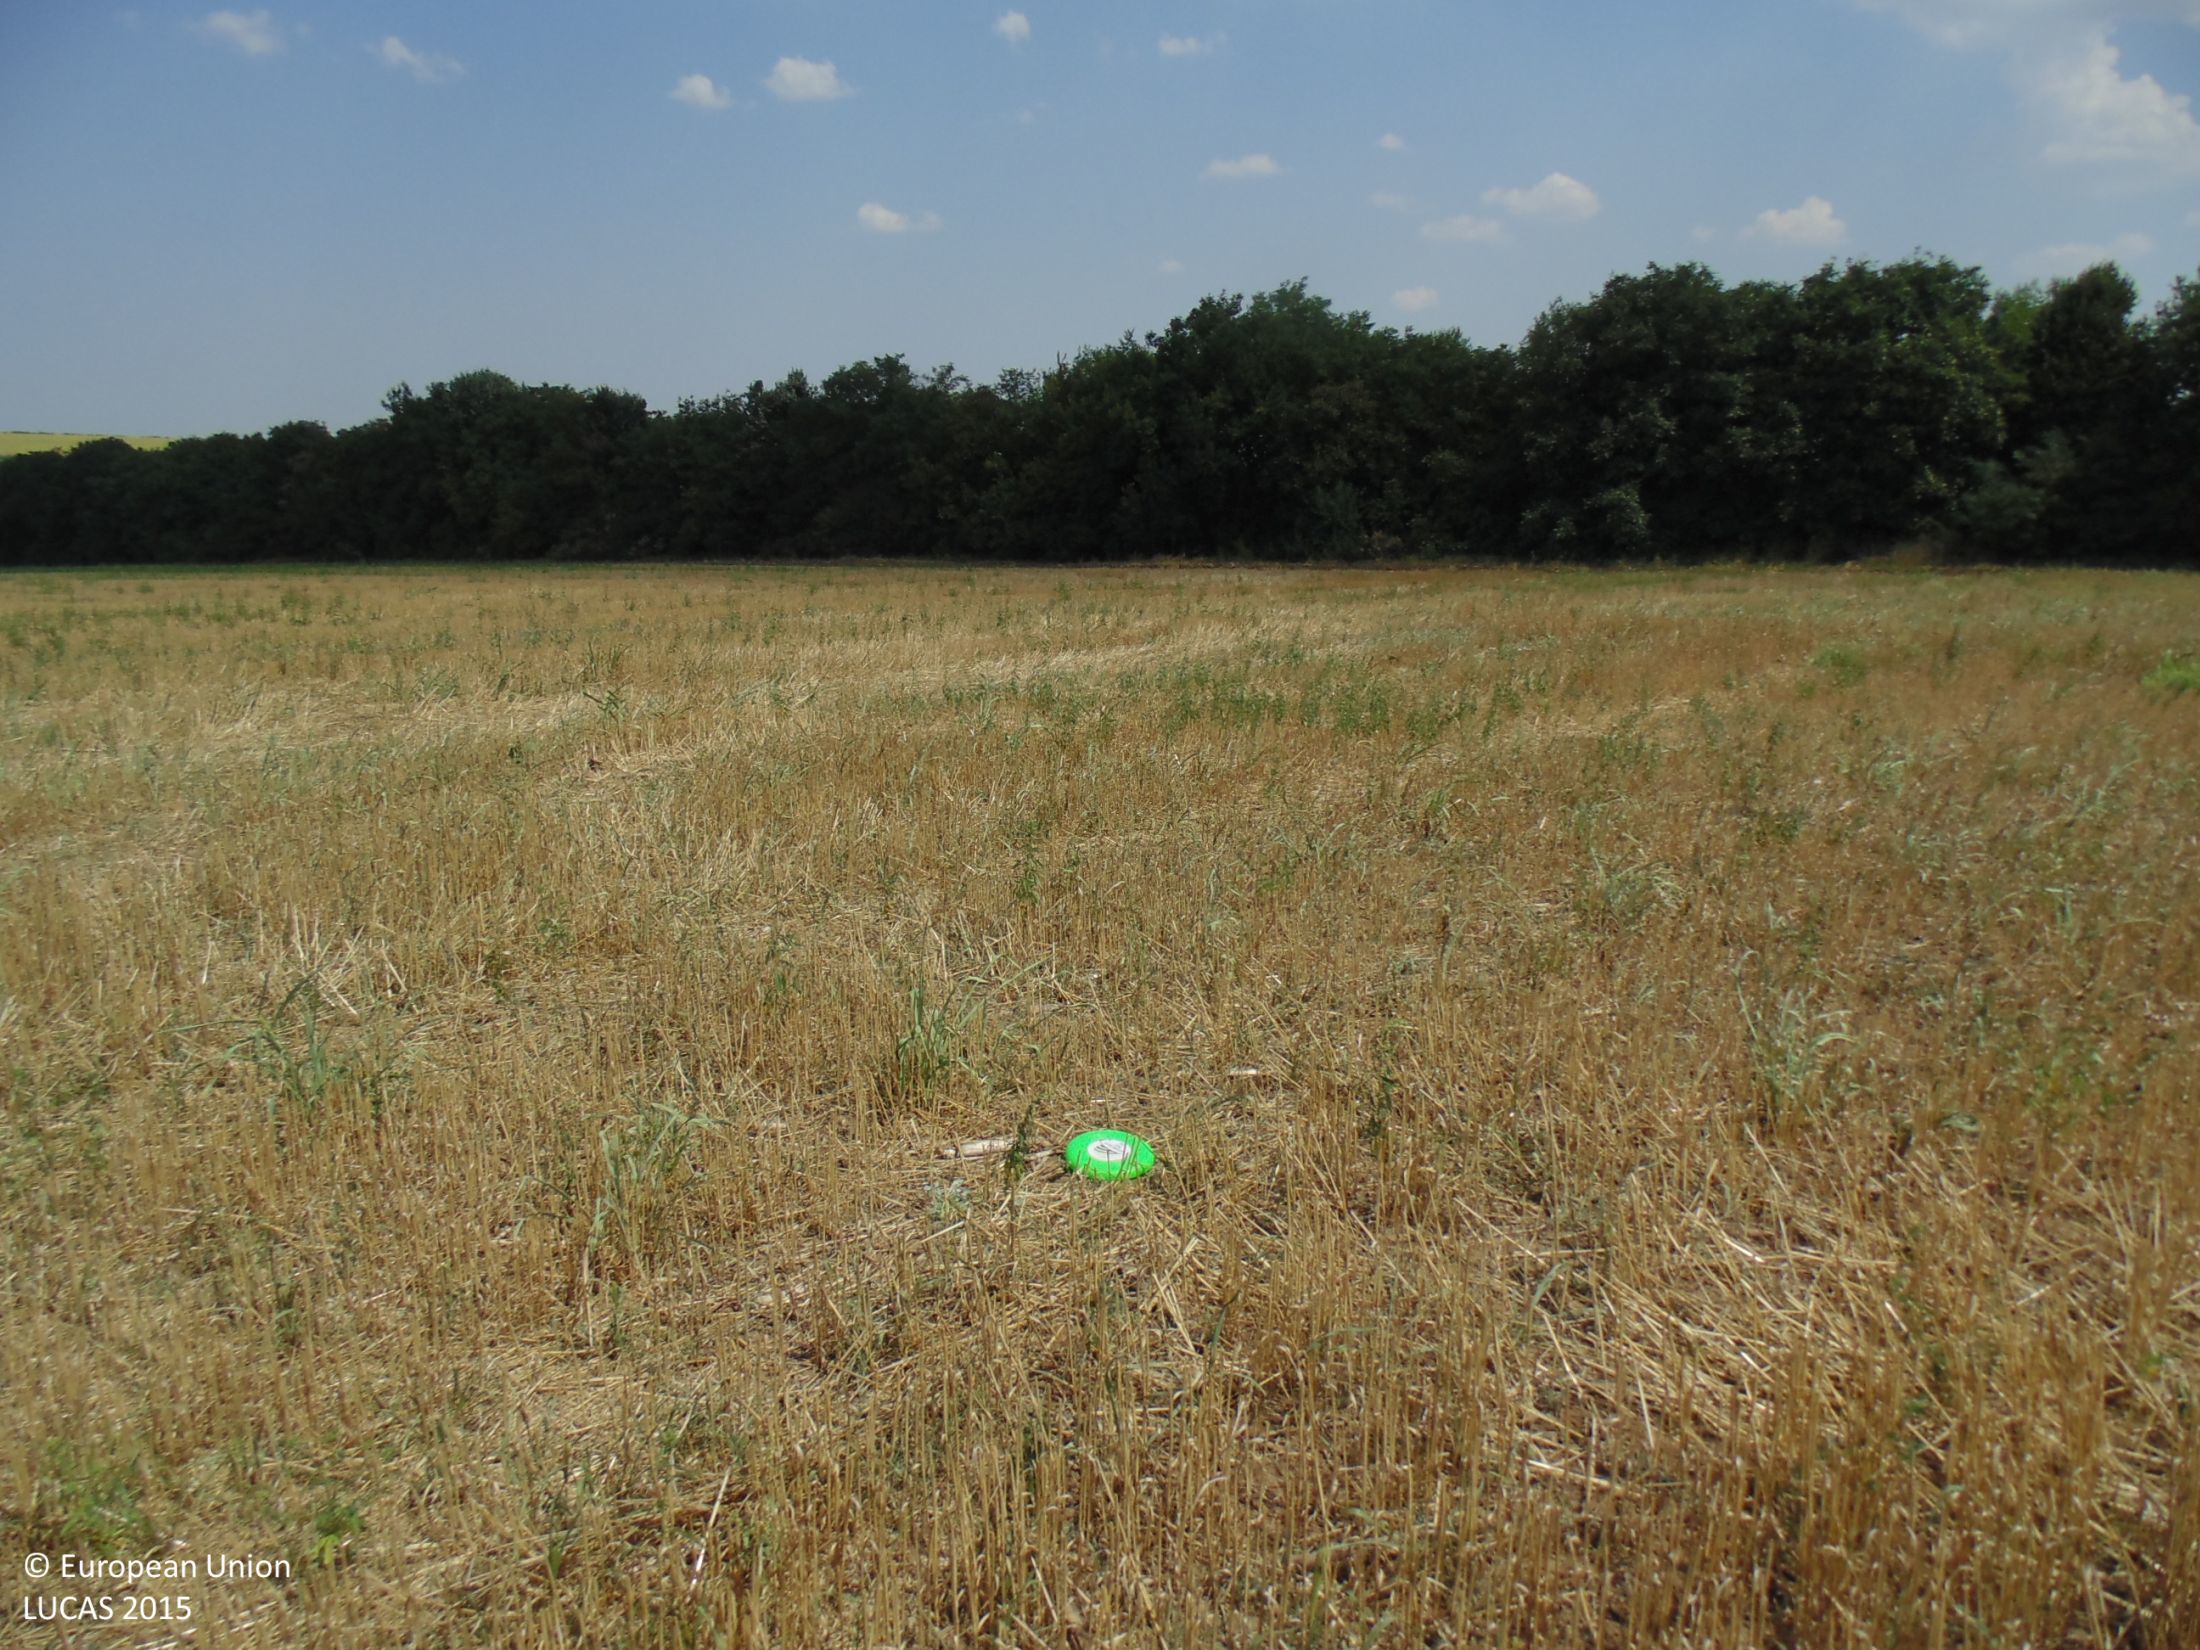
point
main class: Cropland
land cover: Common wheat
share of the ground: > 75 %
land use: Agriculture (excluding fallow land and kitchen gardens)
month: August
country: BG
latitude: 43.7771
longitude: 27.5679
